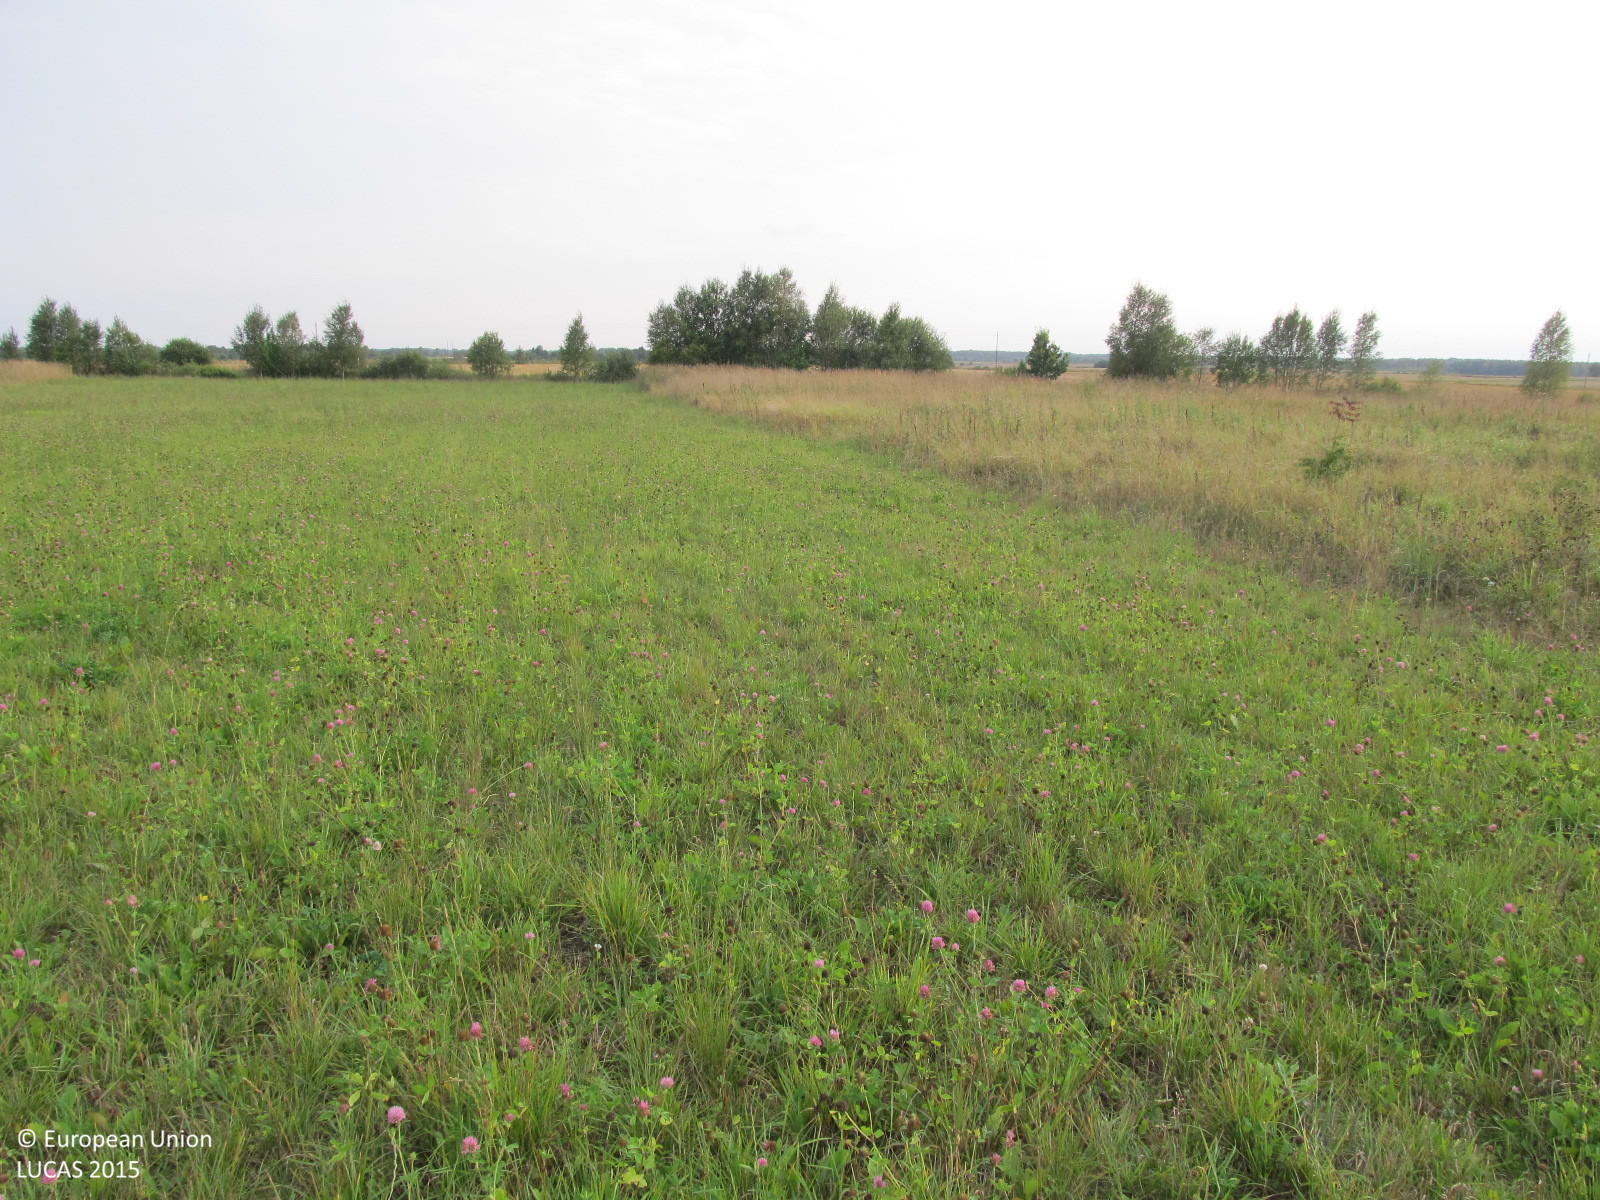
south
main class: Grassland
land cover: Grassland without tree/shrub cover
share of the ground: > 75 %
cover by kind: herbaceous plants 100 %
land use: Agriculture (excluding fallow land and kitchen gardens)
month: September
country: LT
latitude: 56.0617
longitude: 22.5385
